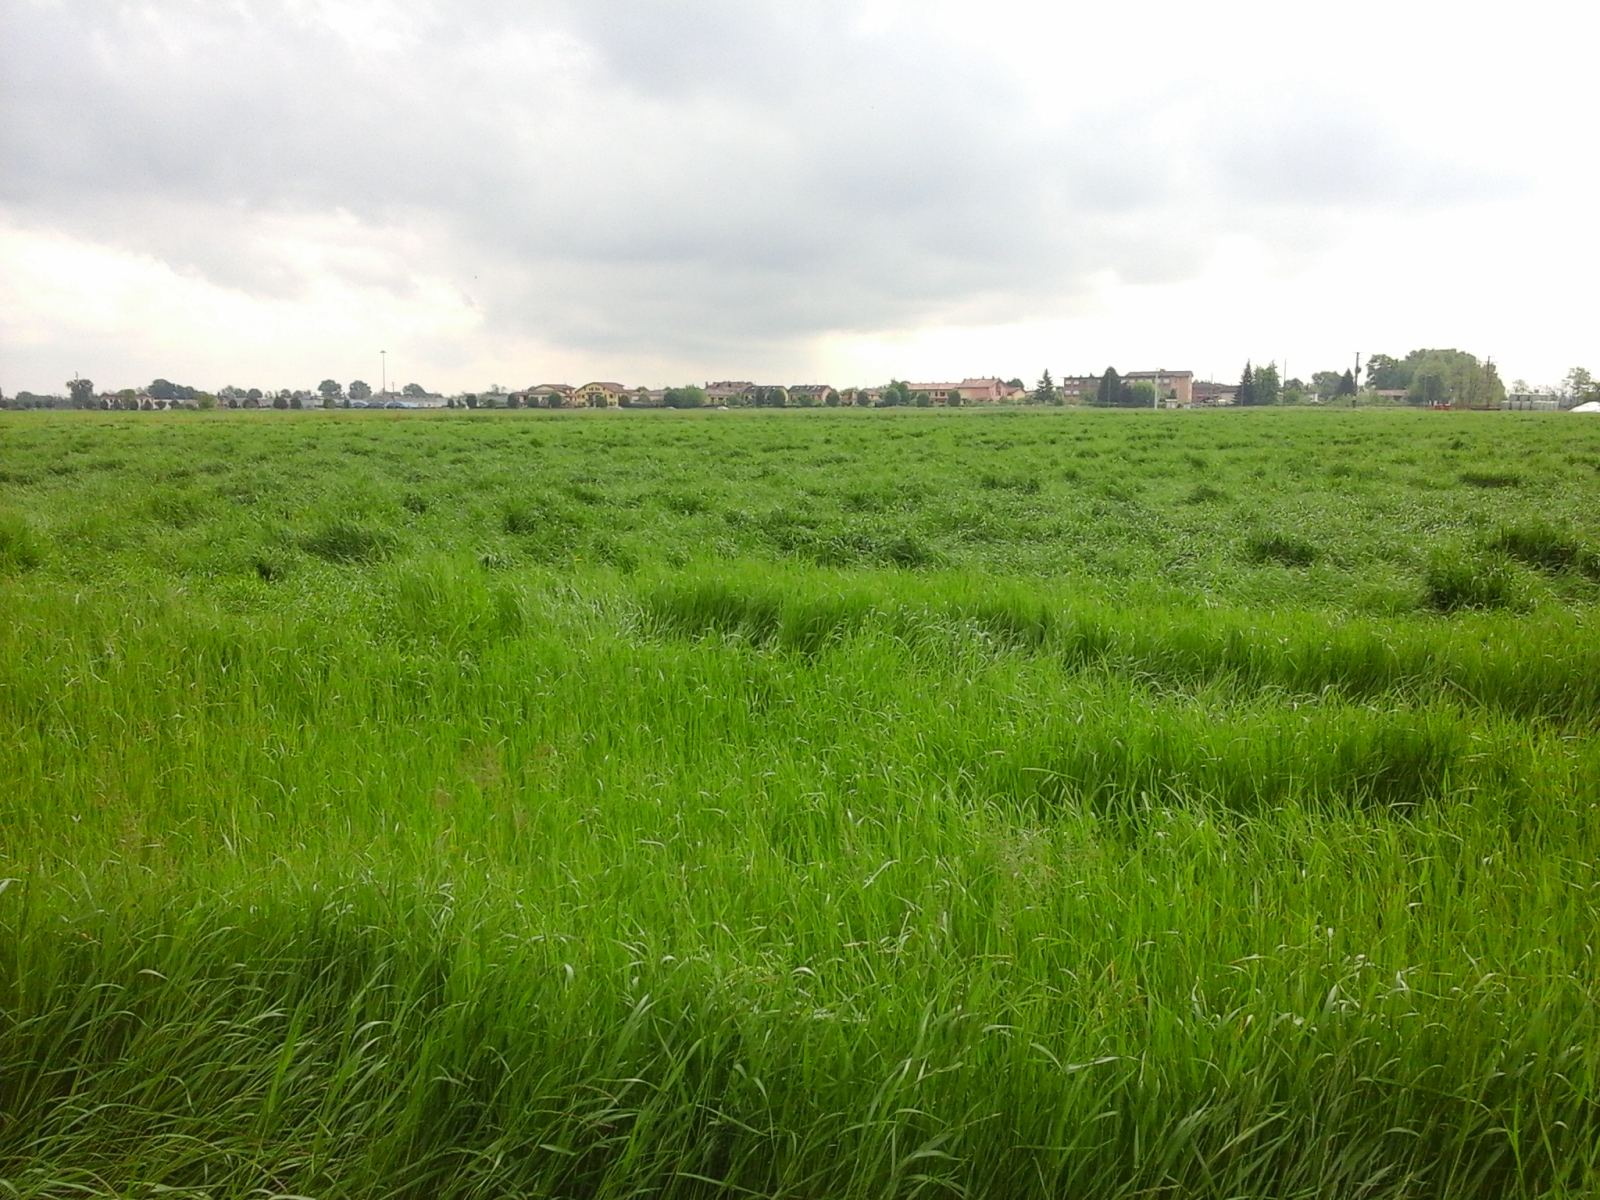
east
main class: Cropland
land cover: Temporary grasslands
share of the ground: > 75 %
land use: Agriculture (excluding fallow land and kitchen gardens)
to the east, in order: Temporary grasslands; Grass margins; Tracks; Grass margins; Ditches and canals; Grass margins; Temporary grasslands; Grass margins; Ditches and canals; Grass margins; Tracks; Grass margins; Maize
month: April
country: IT
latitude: 45.1434
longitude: 9.6827
